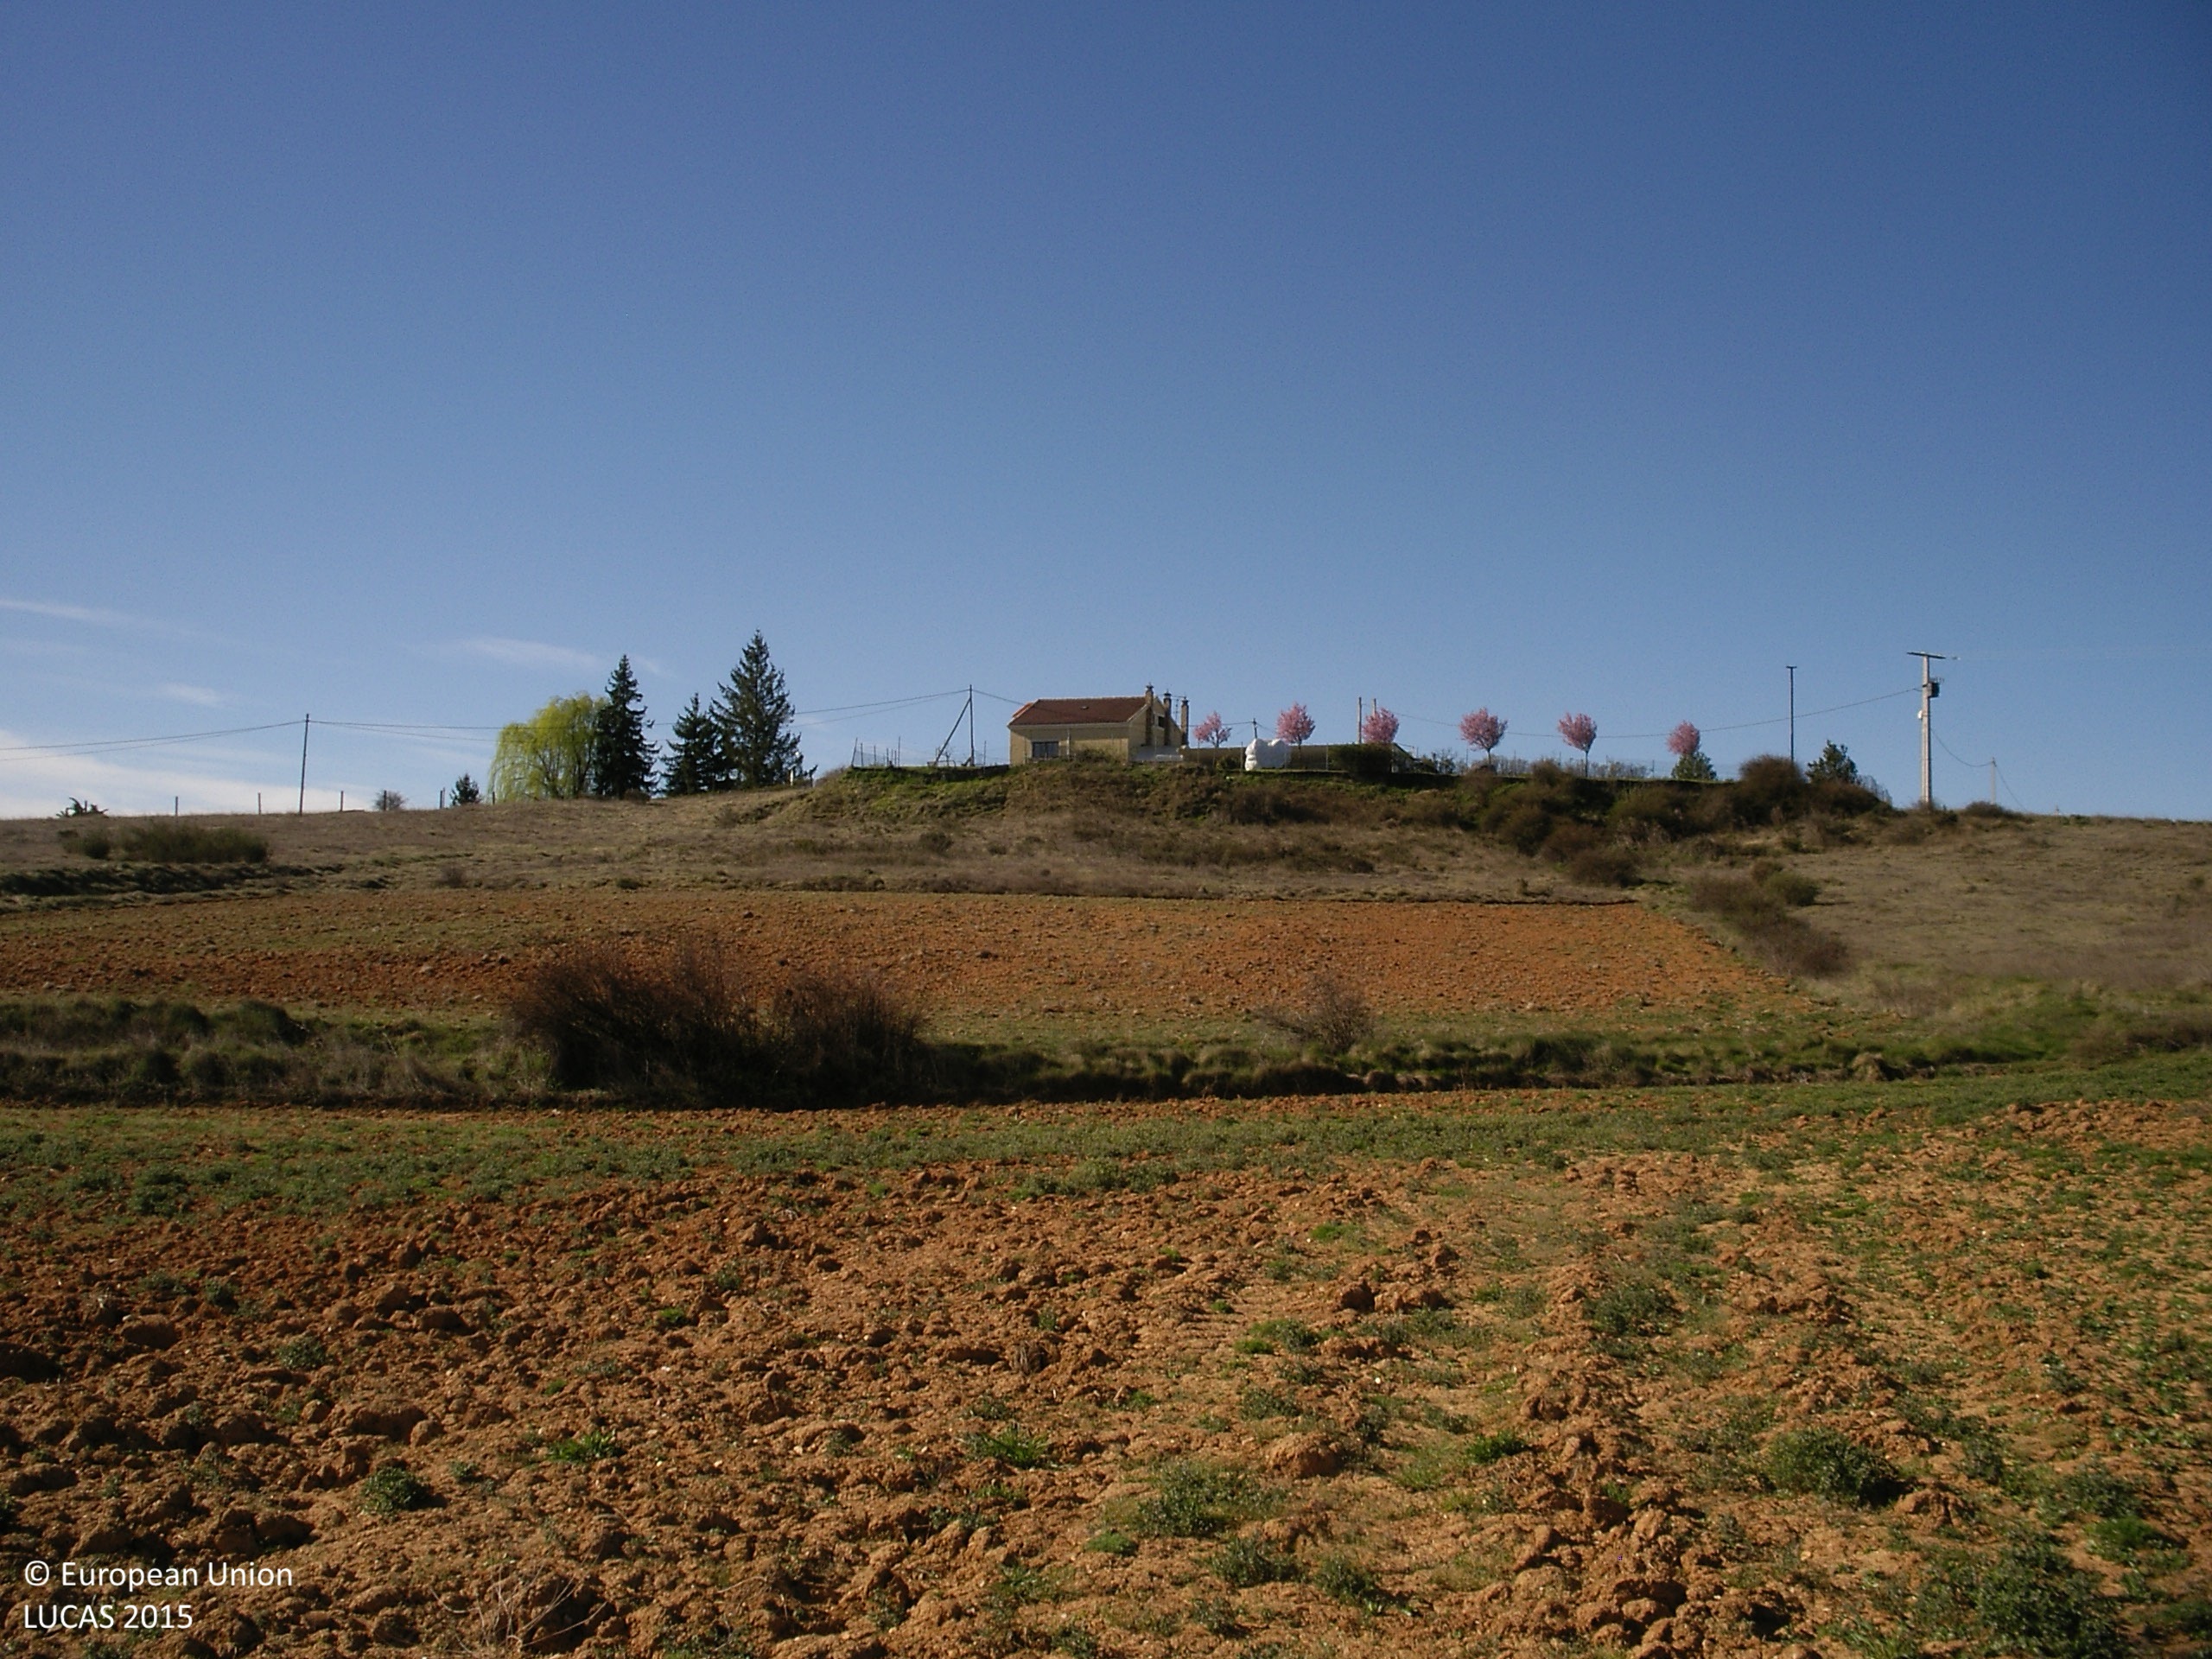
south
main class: Grassland
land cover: Spontaneously vegetated surfaces
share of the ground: > 75 %
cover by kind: consolidated bare surface 60 %, herbaceous plants 40 %
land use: Fallow land
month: March
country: ES
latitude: 42.4454
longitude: -6.0694
